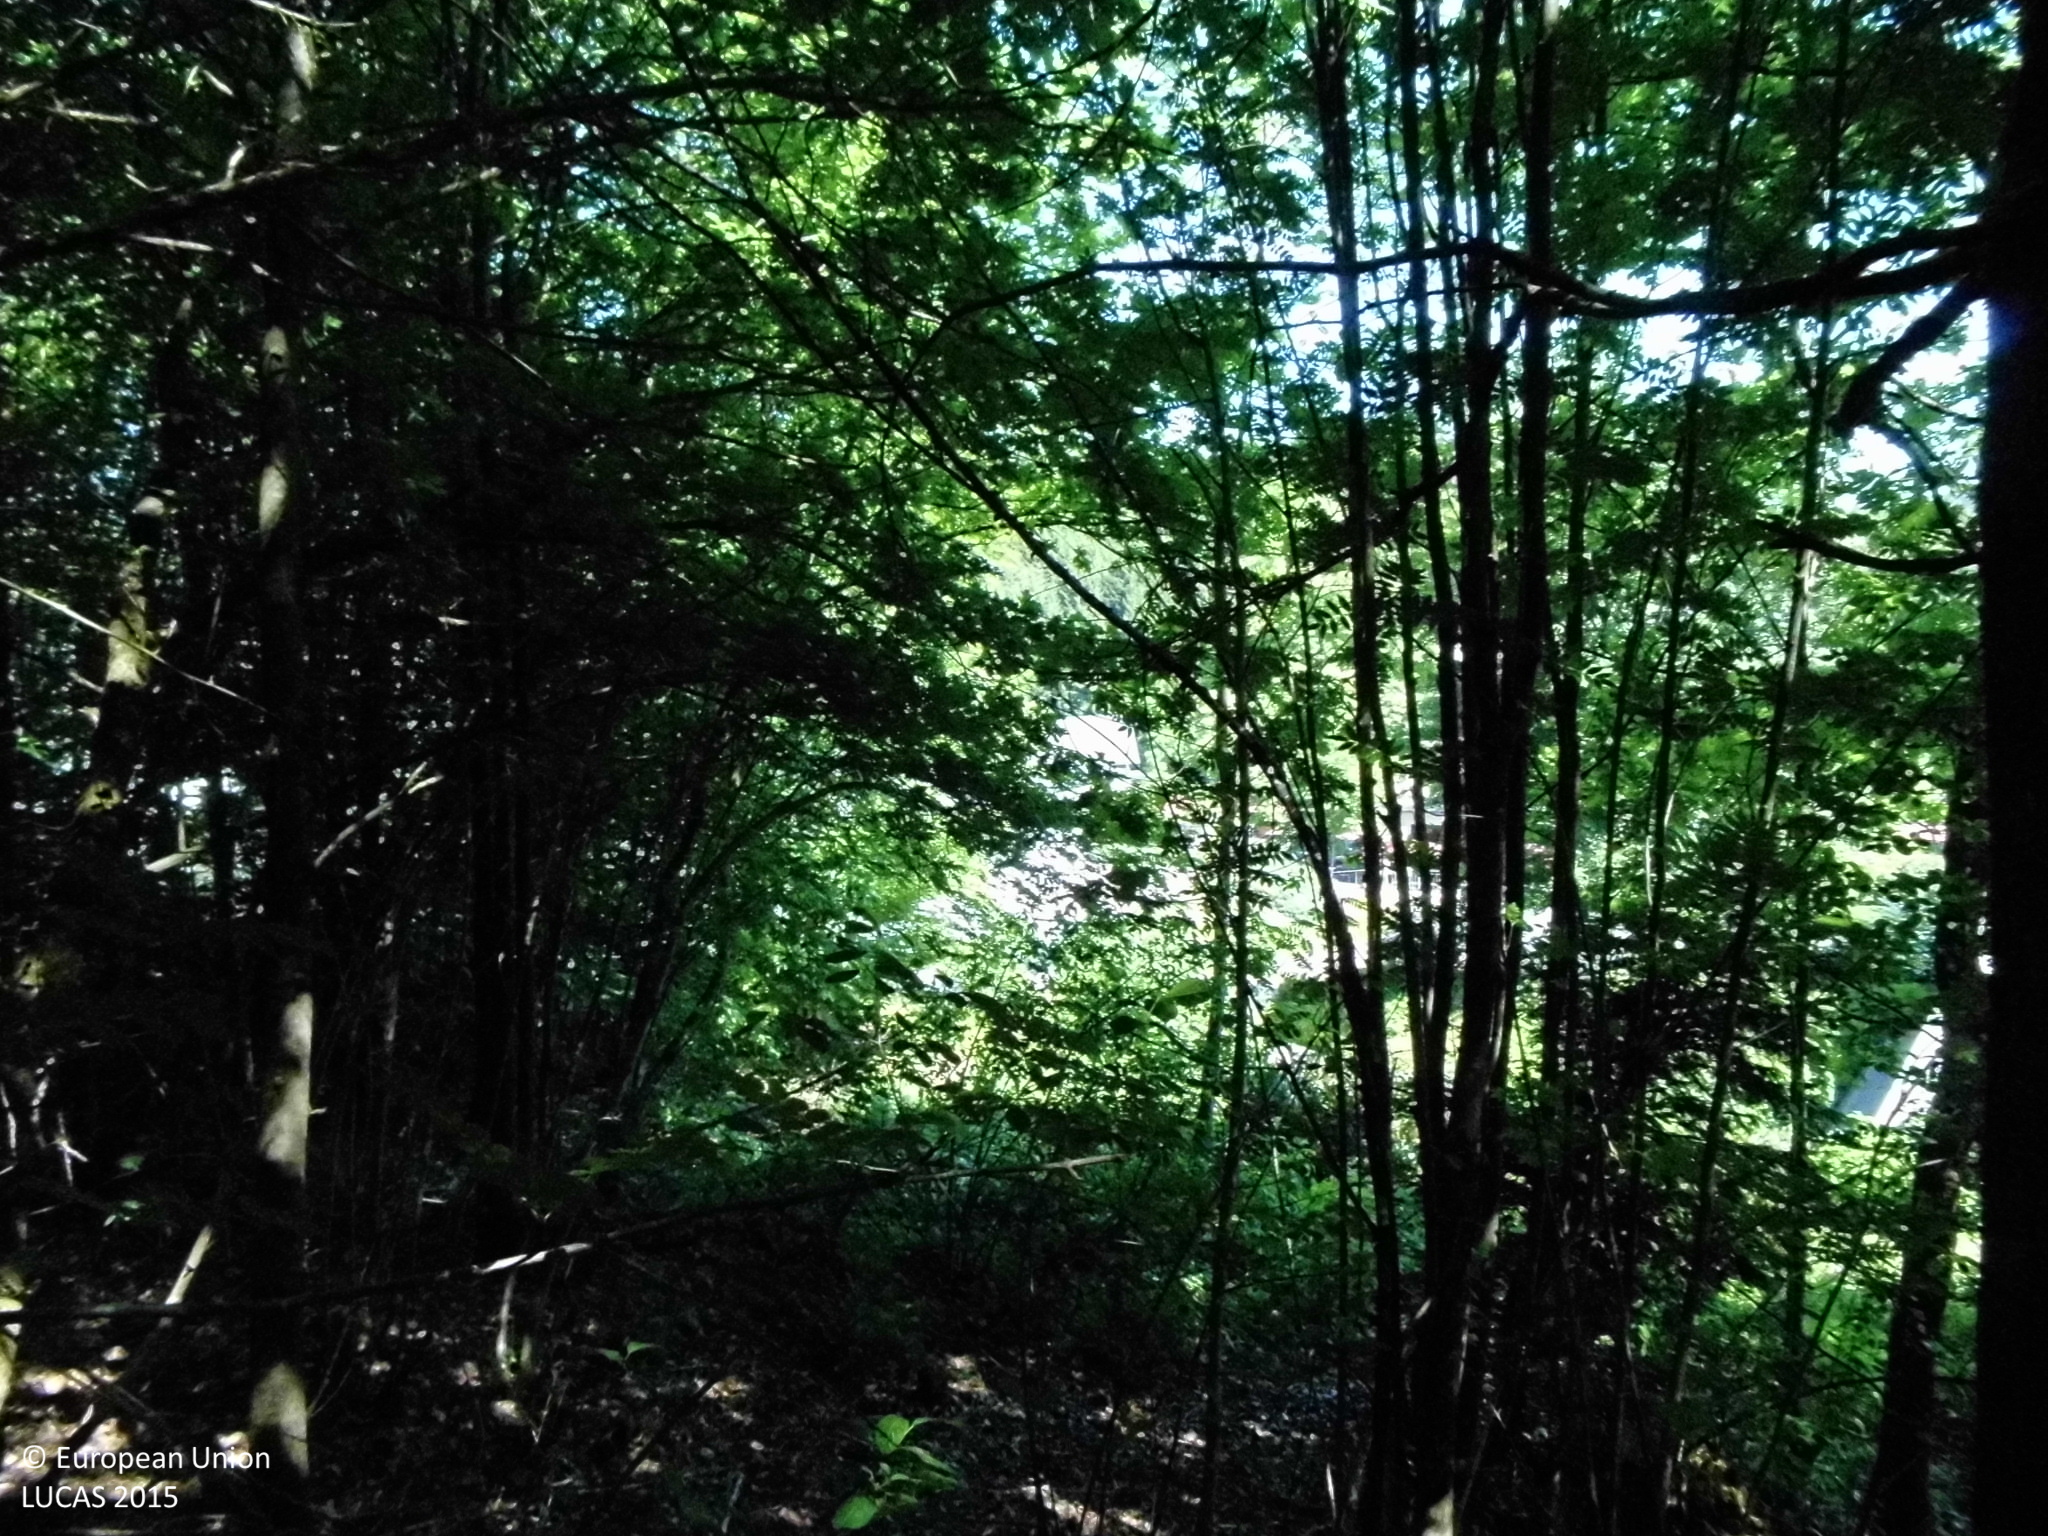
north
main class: Woodland
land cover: Broadleaved woodland
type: mesophytic deciduous forest
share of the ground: > 75 %
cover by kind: broadleaved forest trees 85 %, coniferous forest trees 15 %
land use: Forestry
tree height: > 5 m
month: June
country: DE
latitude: 50.9220
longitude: 7.9945
